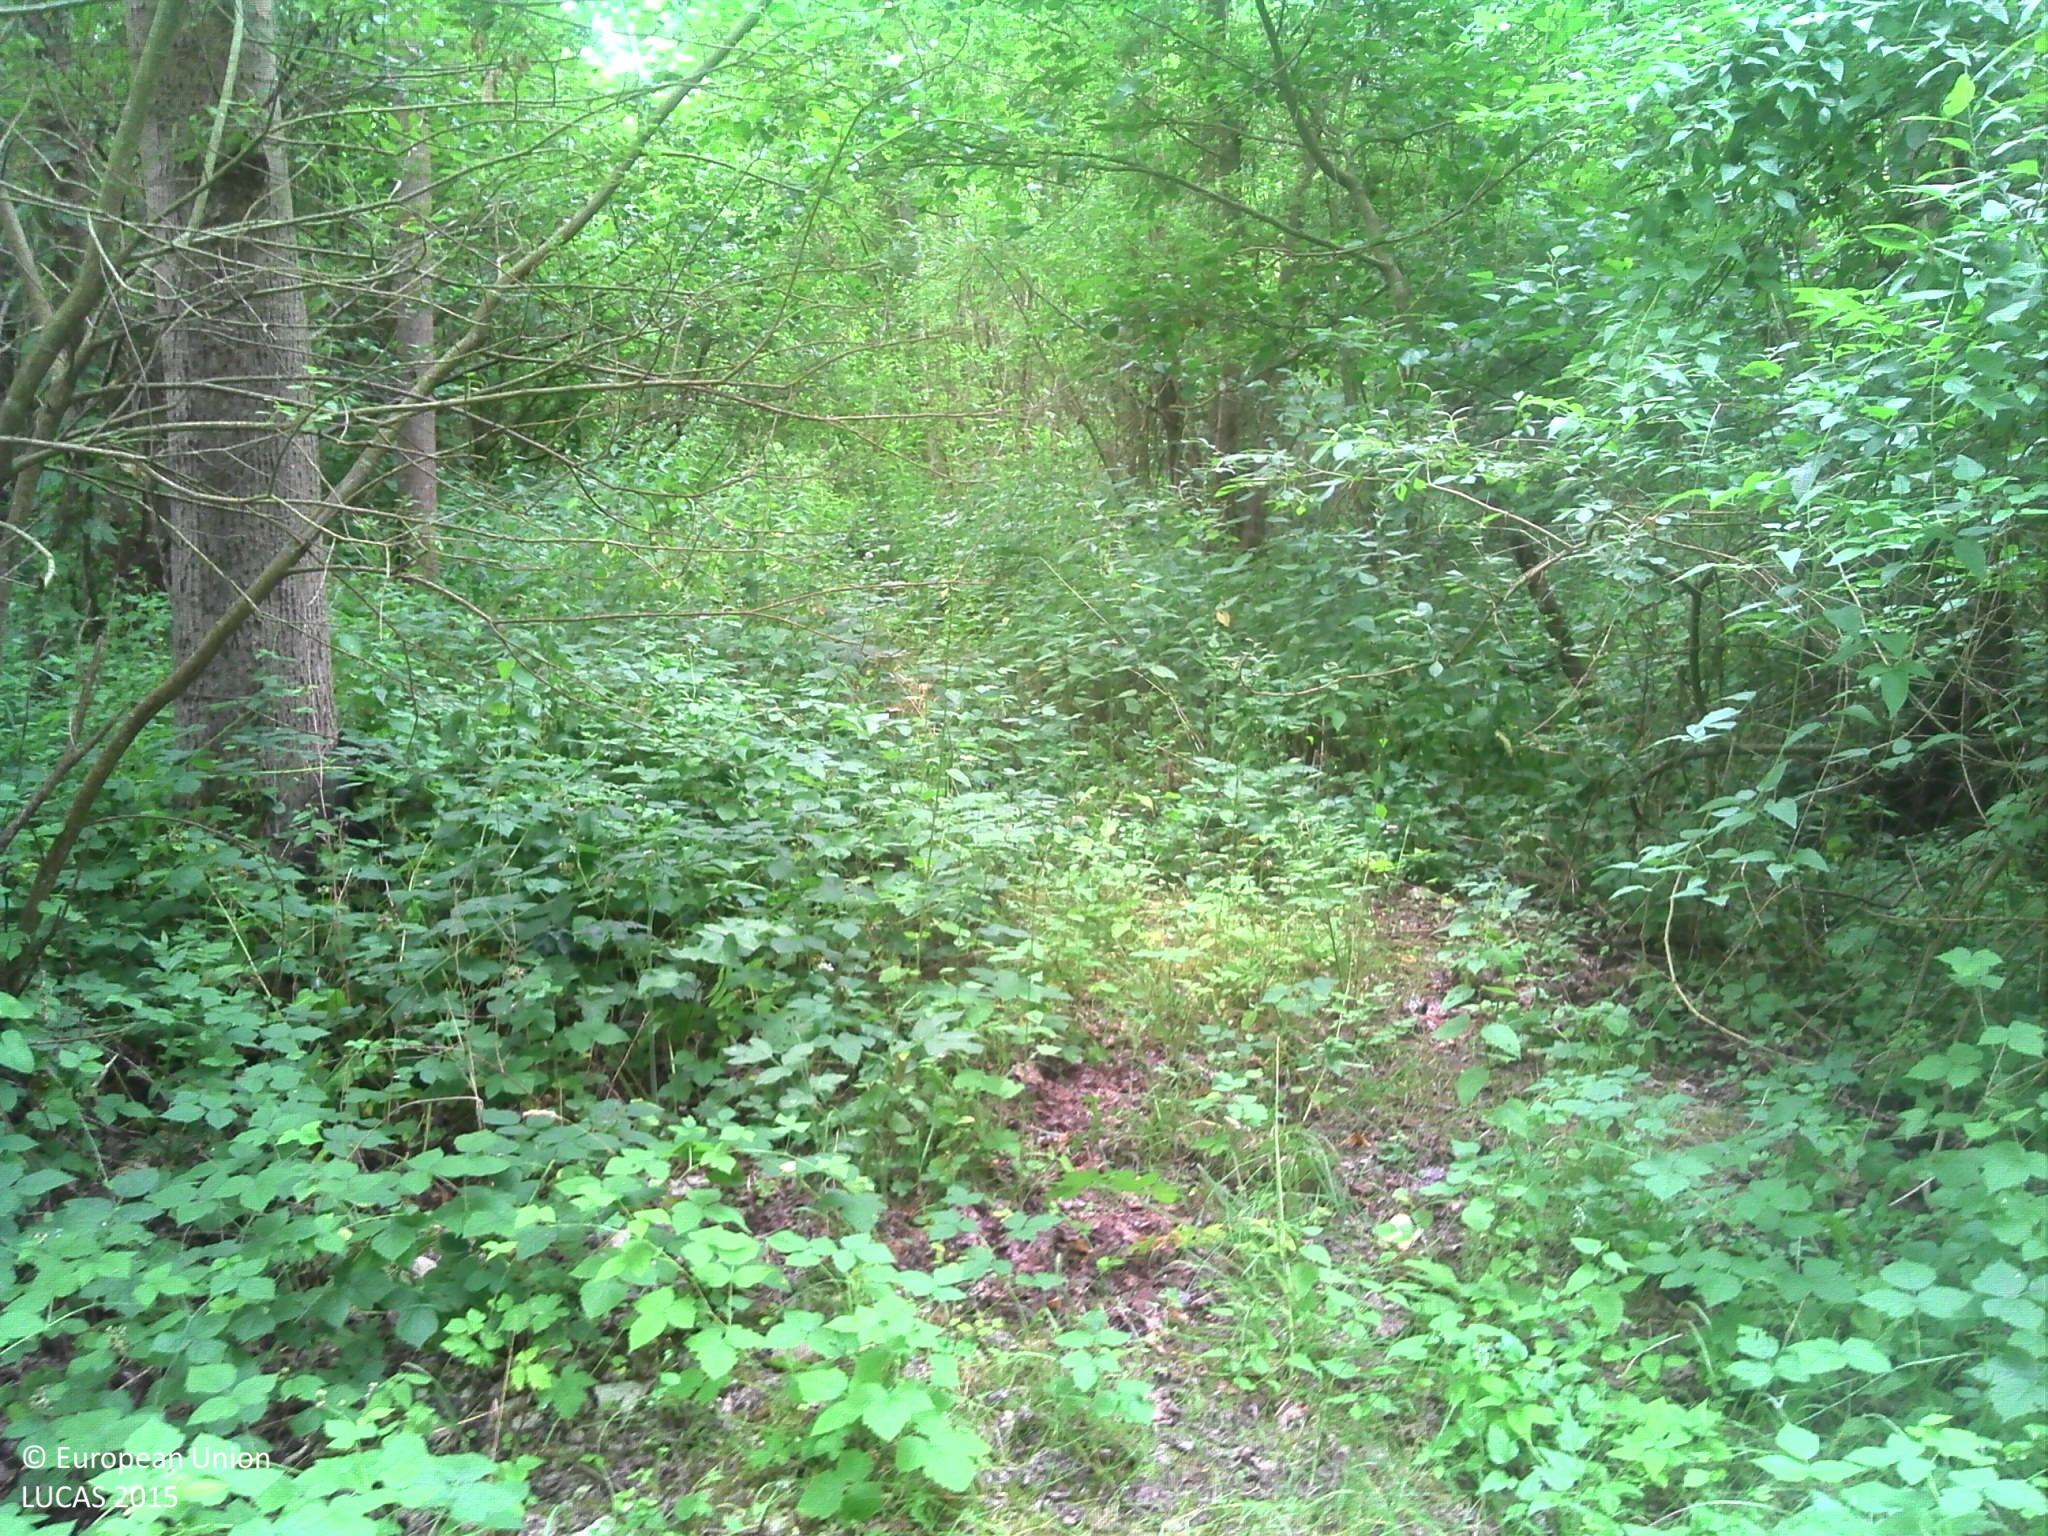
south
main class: Woodland
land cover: Broadleaved woodland
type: floodplain forest
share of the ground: > 75 %
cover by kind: broadleaved forest trees 85 %, herbaceous plants 15 %
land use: Forestry
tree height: > 5 m
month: July
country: FR
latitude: 49.1936
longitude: 3.3095
